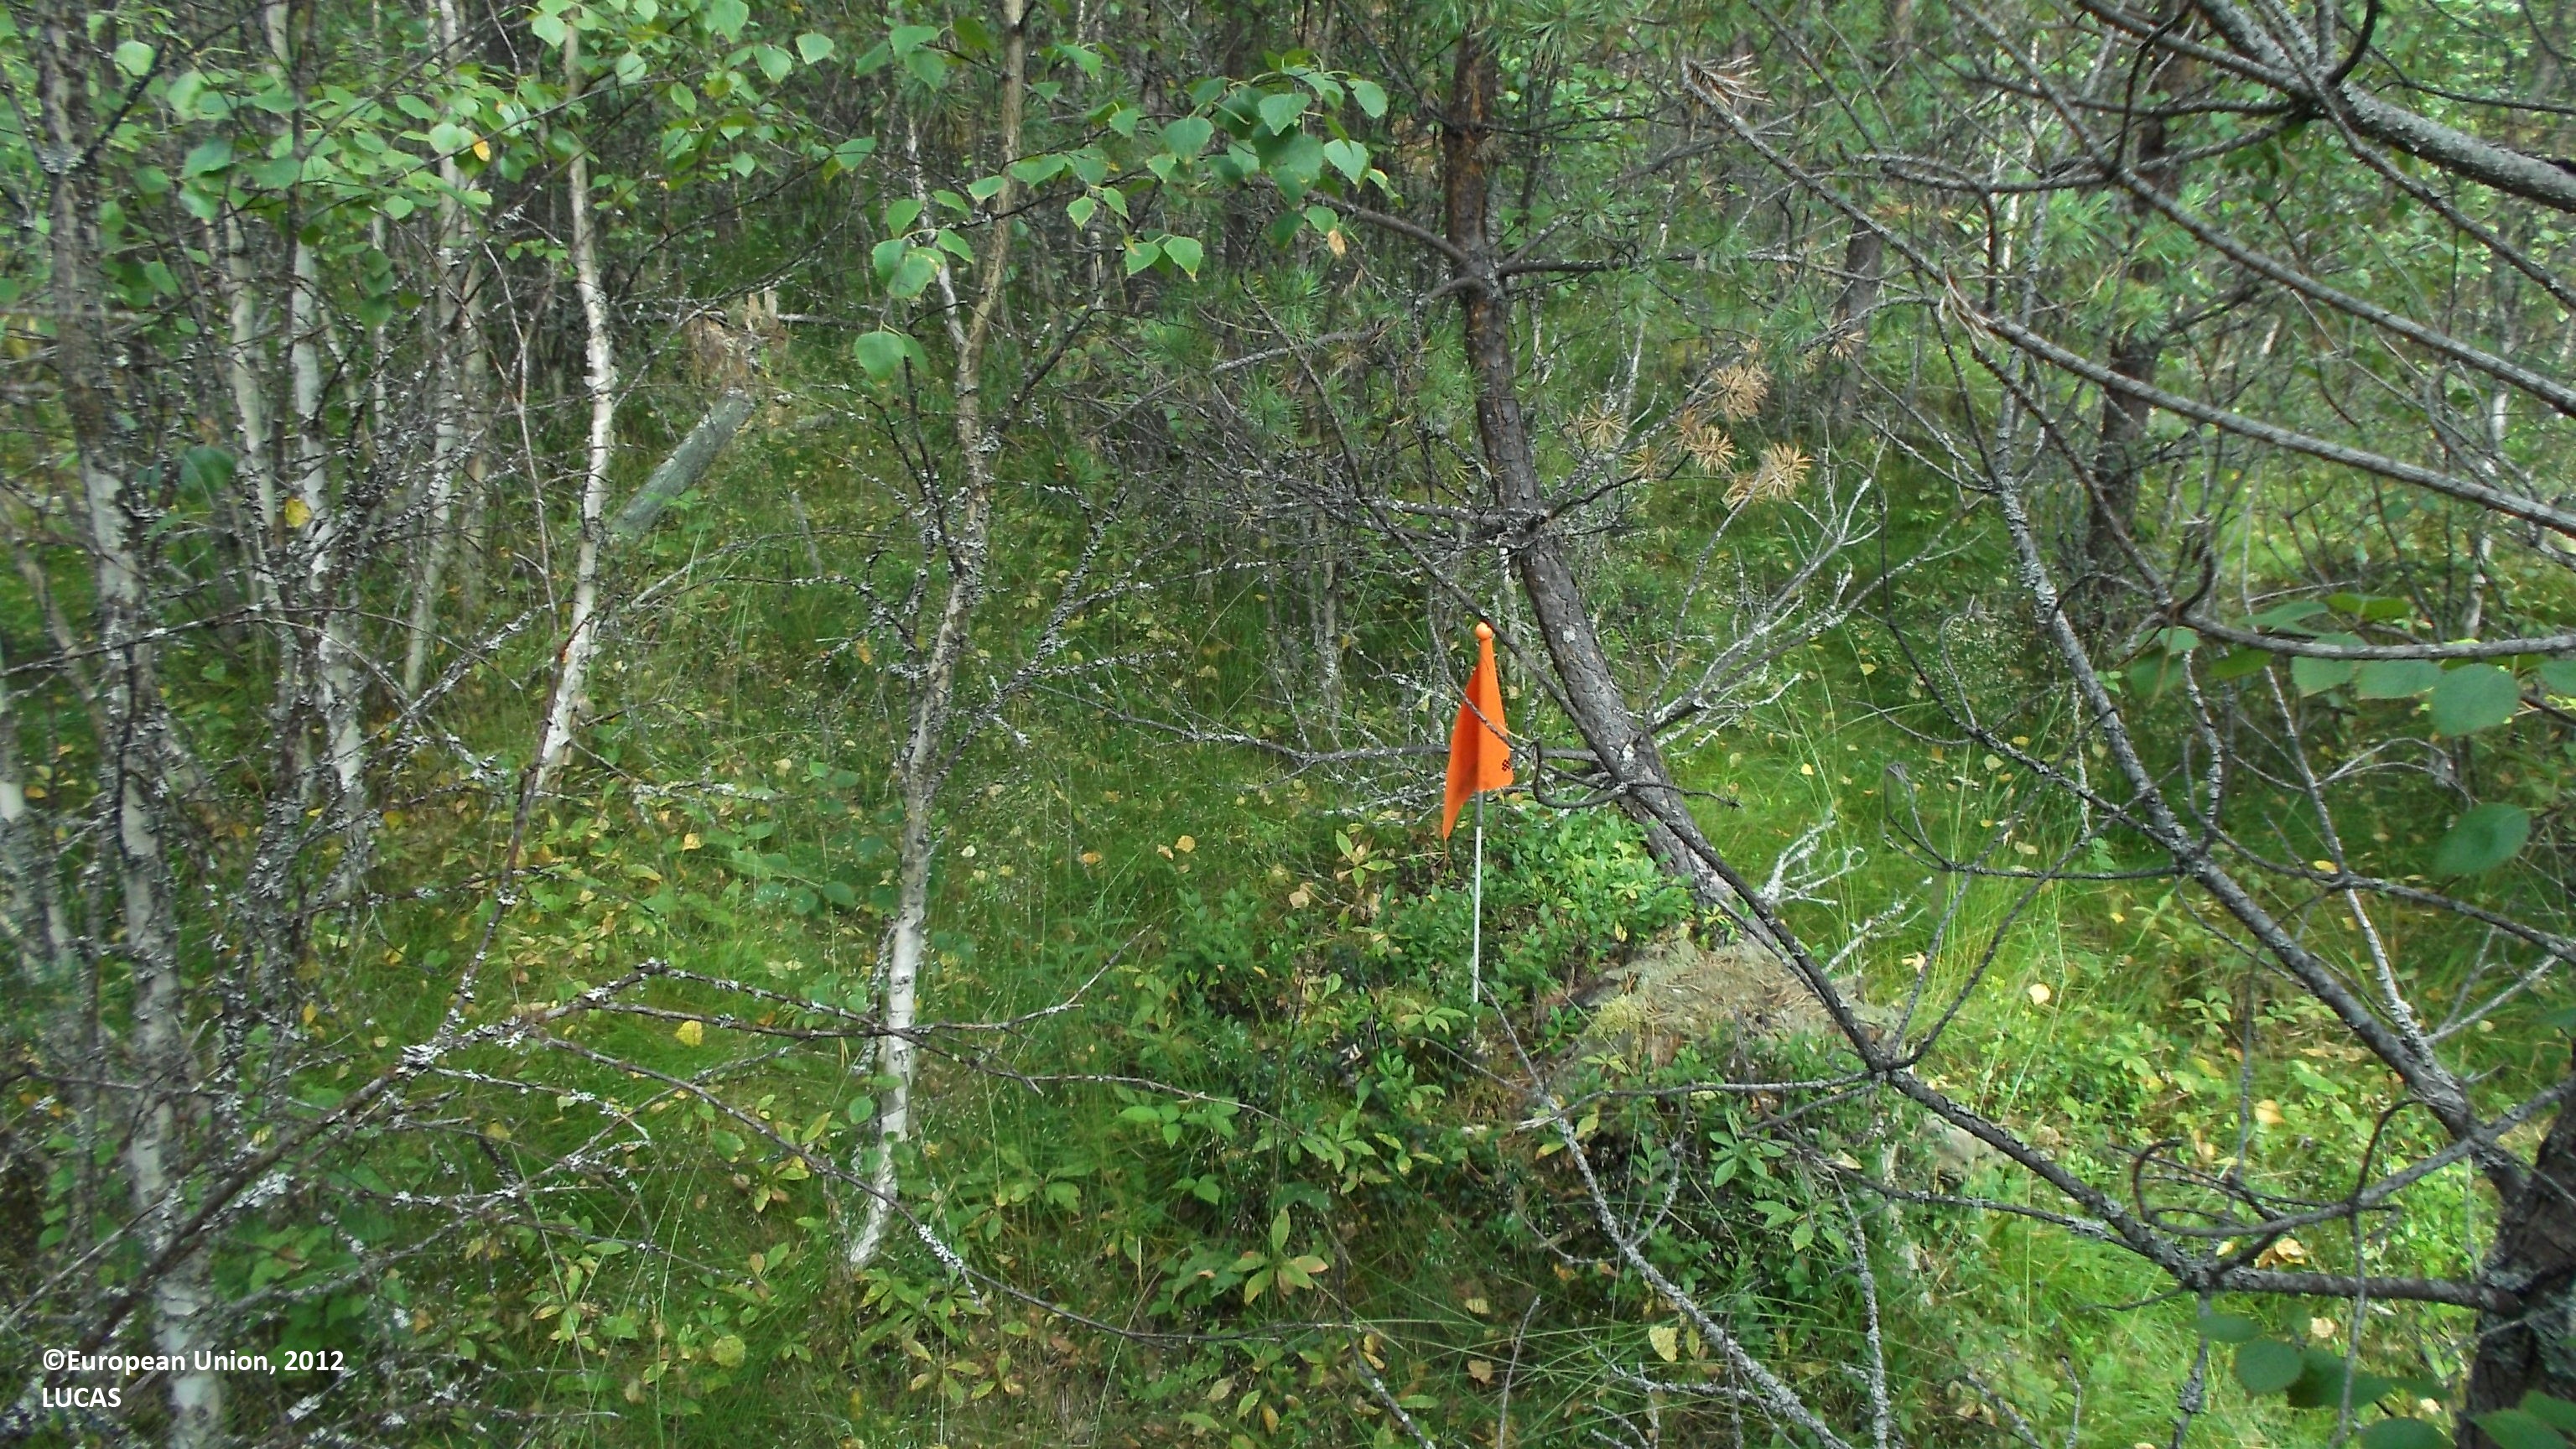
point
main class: Woodland
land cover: Other mixed woodland
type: boreal forest
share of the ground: 50 - 75 %
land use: Forestry
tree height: > 5 m
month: July
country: FI
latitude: 63.6638
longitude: 23.3725
